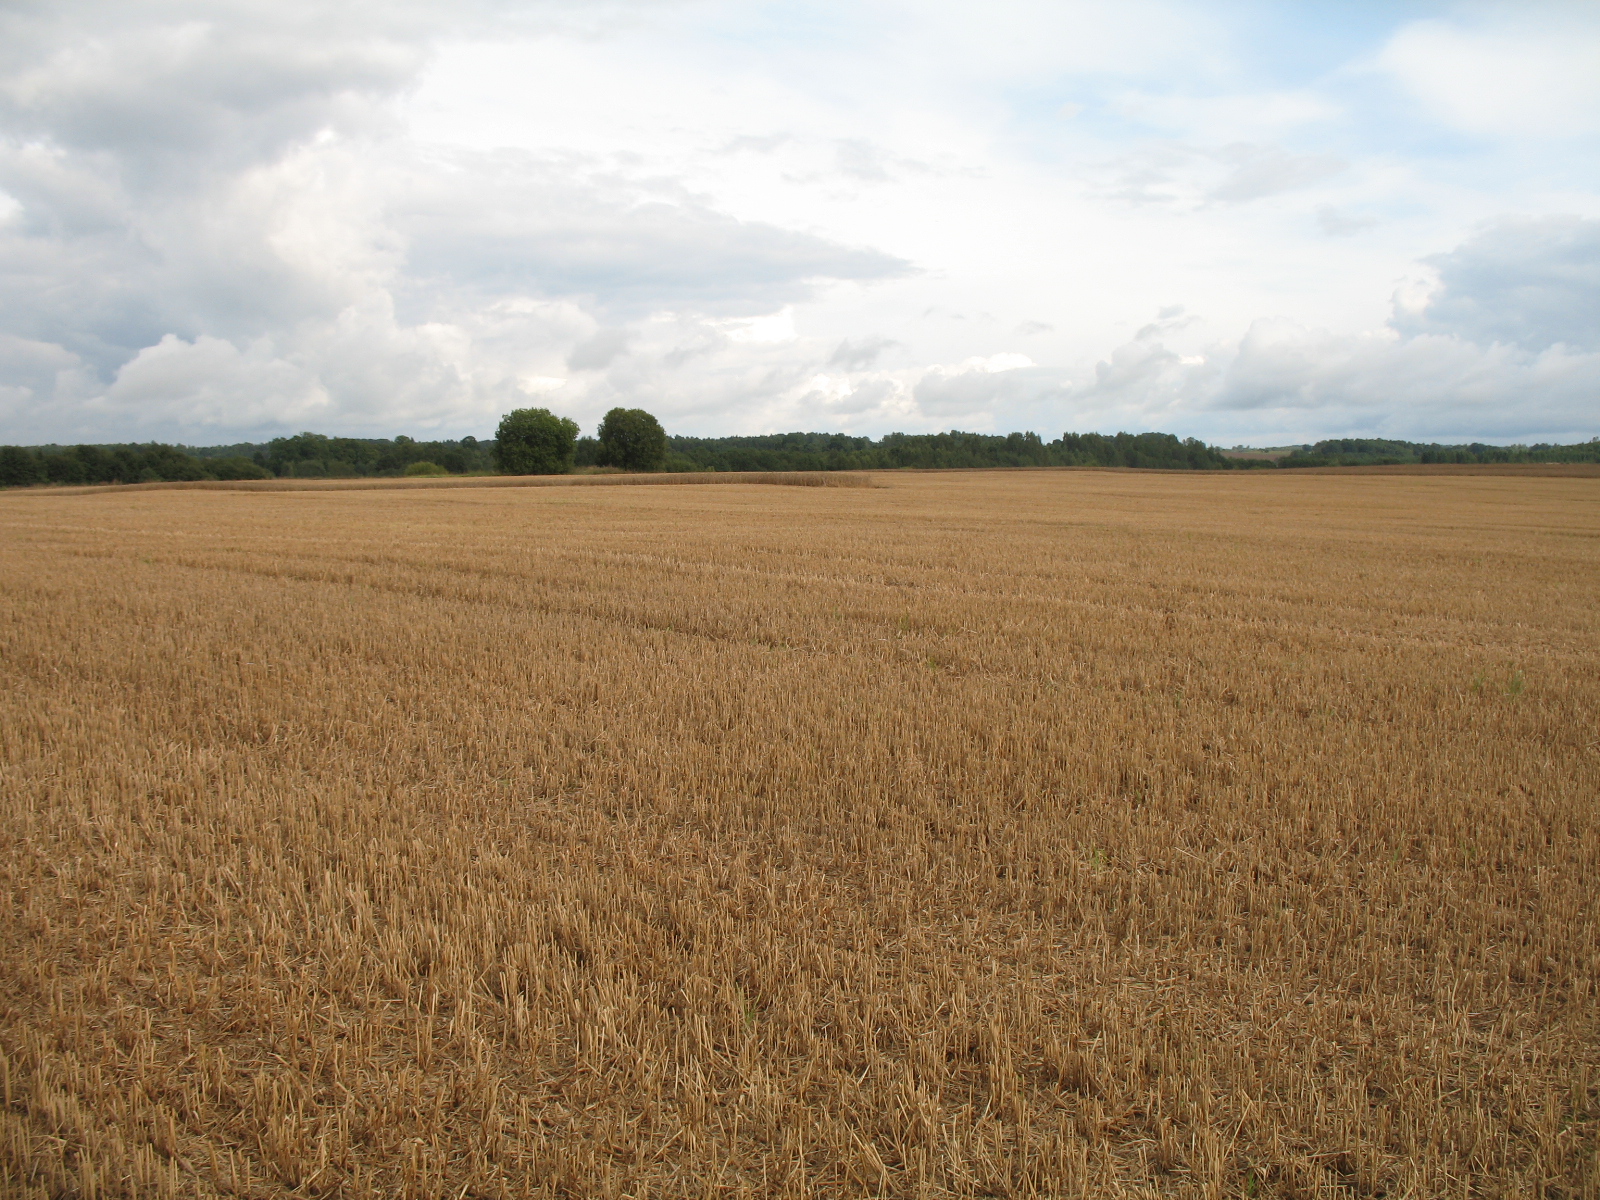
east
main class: Cropland
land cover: Common wheat
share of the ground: < 10 %
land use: Agriculture (excluding fallow land and kitchen gardens)
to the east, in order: Common wheat; Spontaneously vegetated surfaces; Single bushes/trees
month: September
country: LV
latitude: 56.0872
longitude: 25.8983
